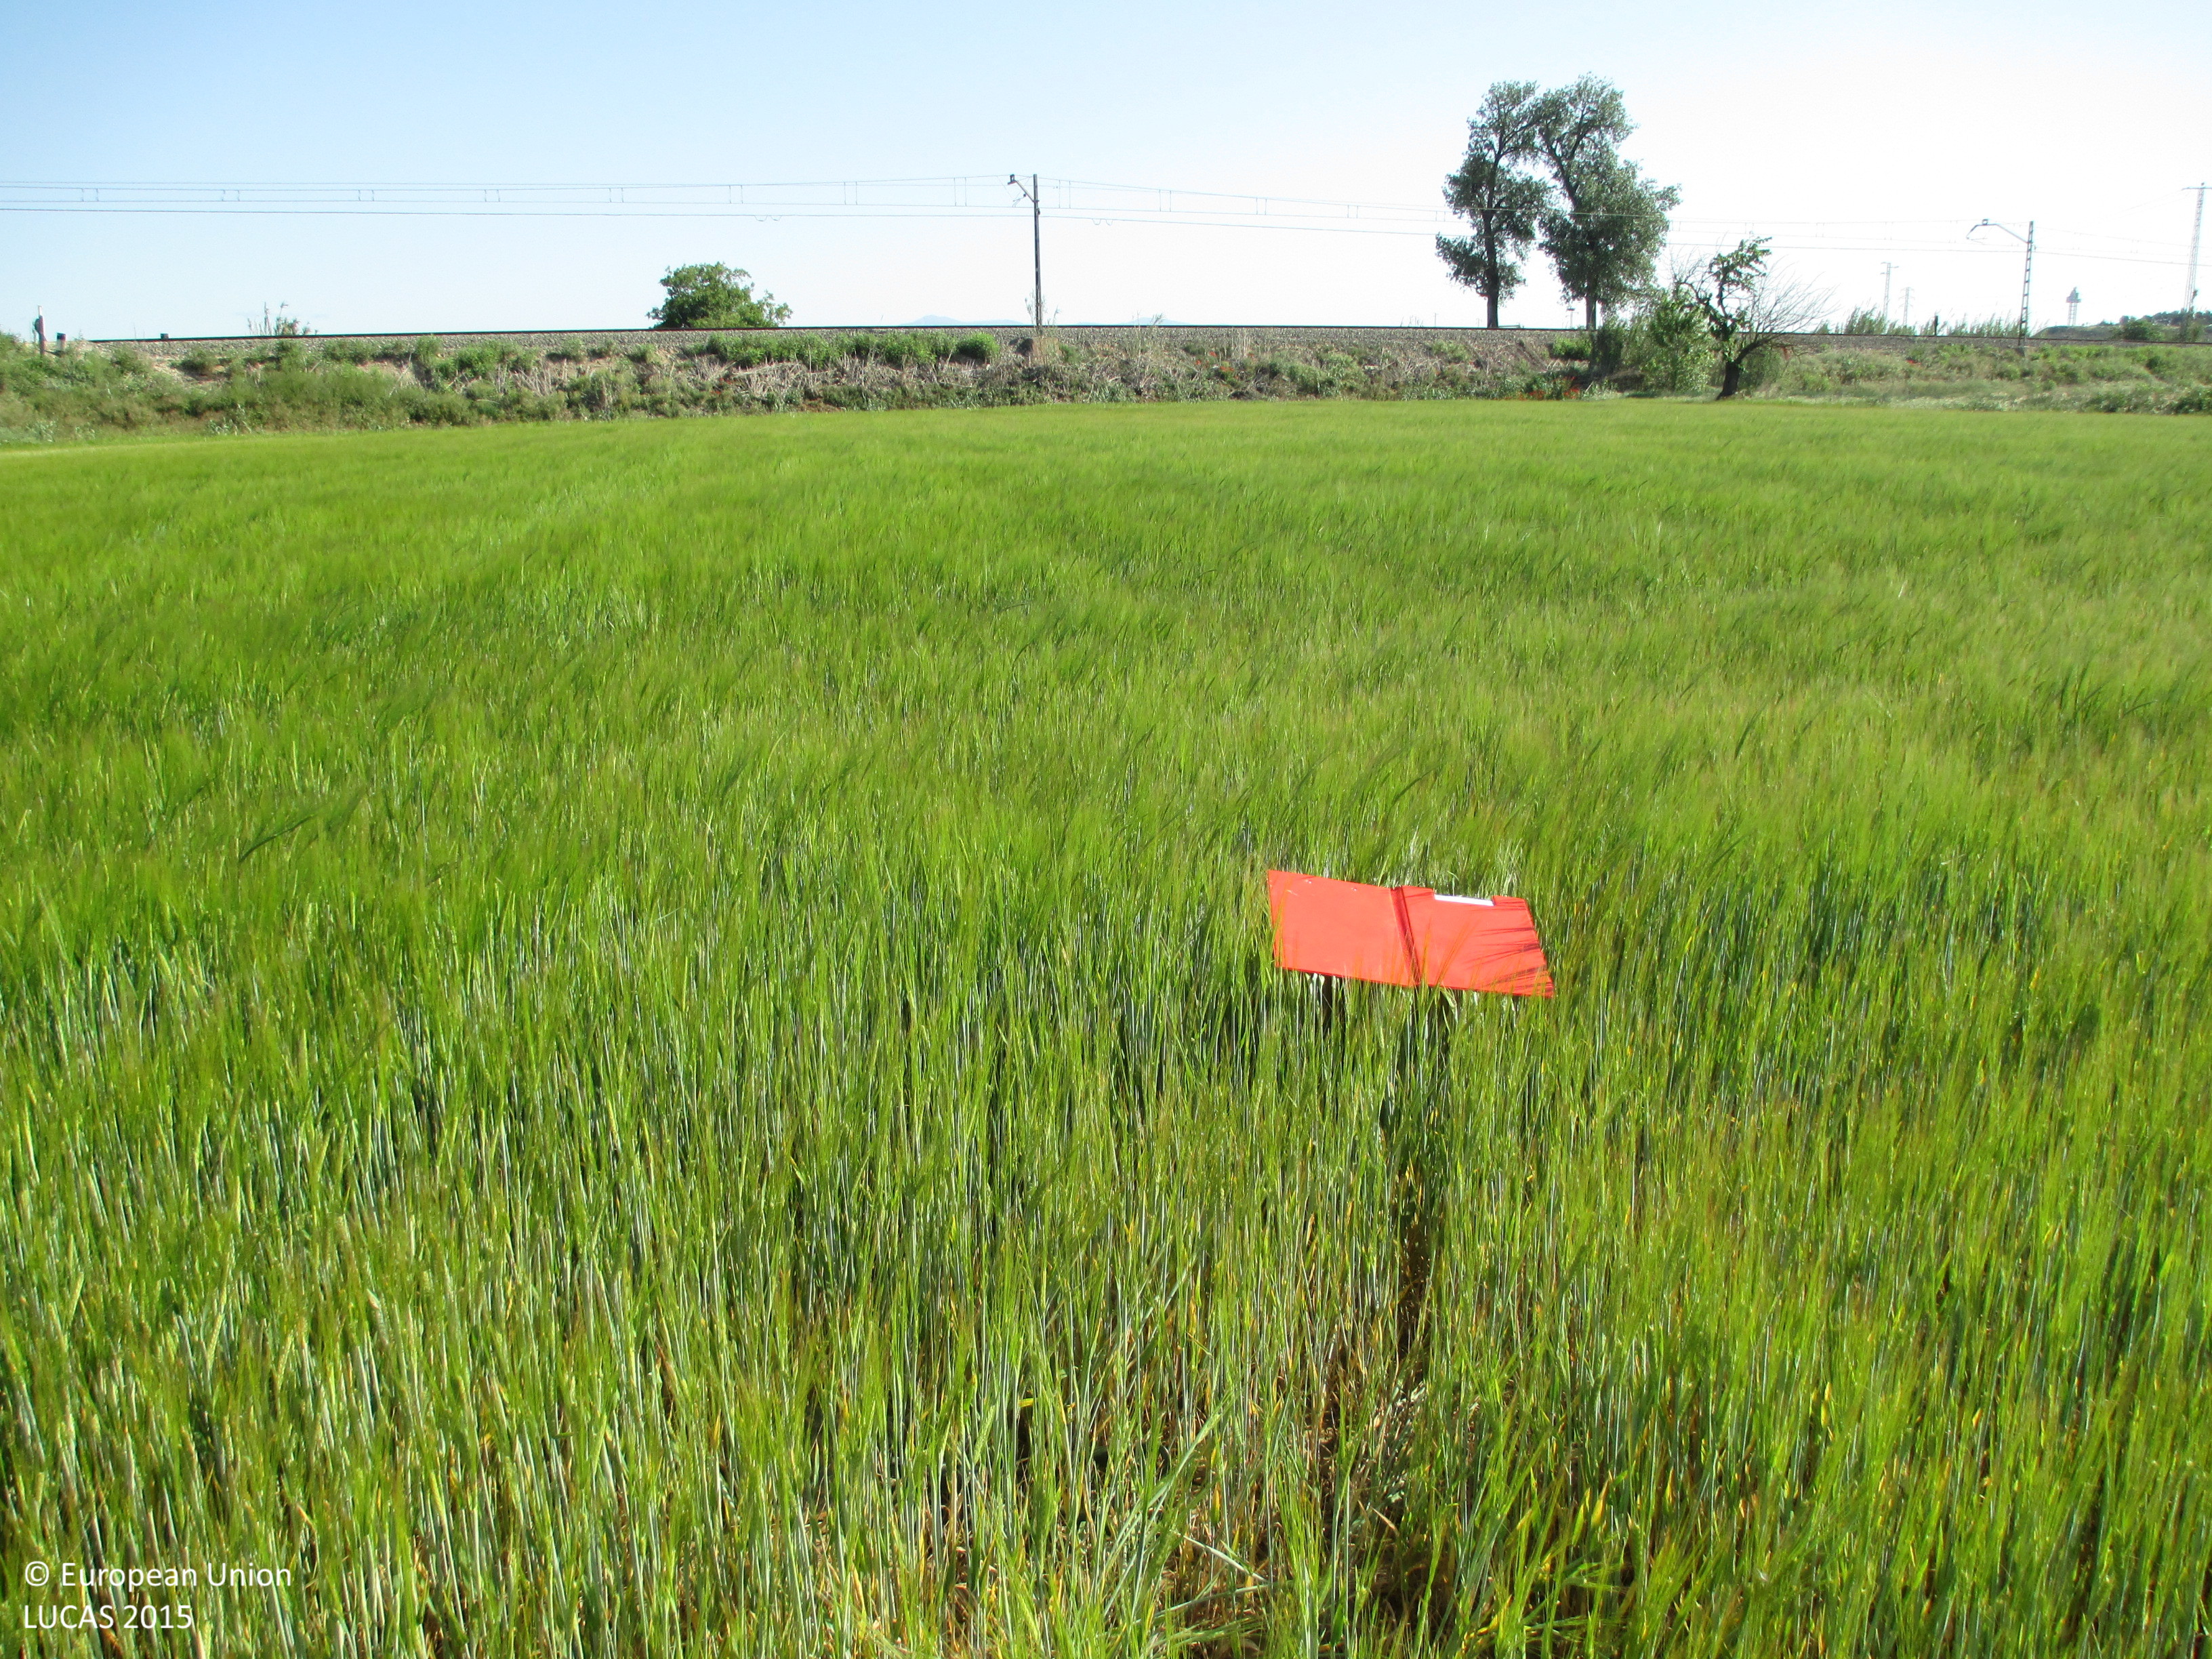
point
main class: Cropland
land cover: Barley
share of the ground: > 75 %
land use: Agriculture (excluding fallow land and kitchen gardens)
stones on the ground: < 10 %
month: May
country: ES
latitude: 41.9372
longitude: -0.3810
